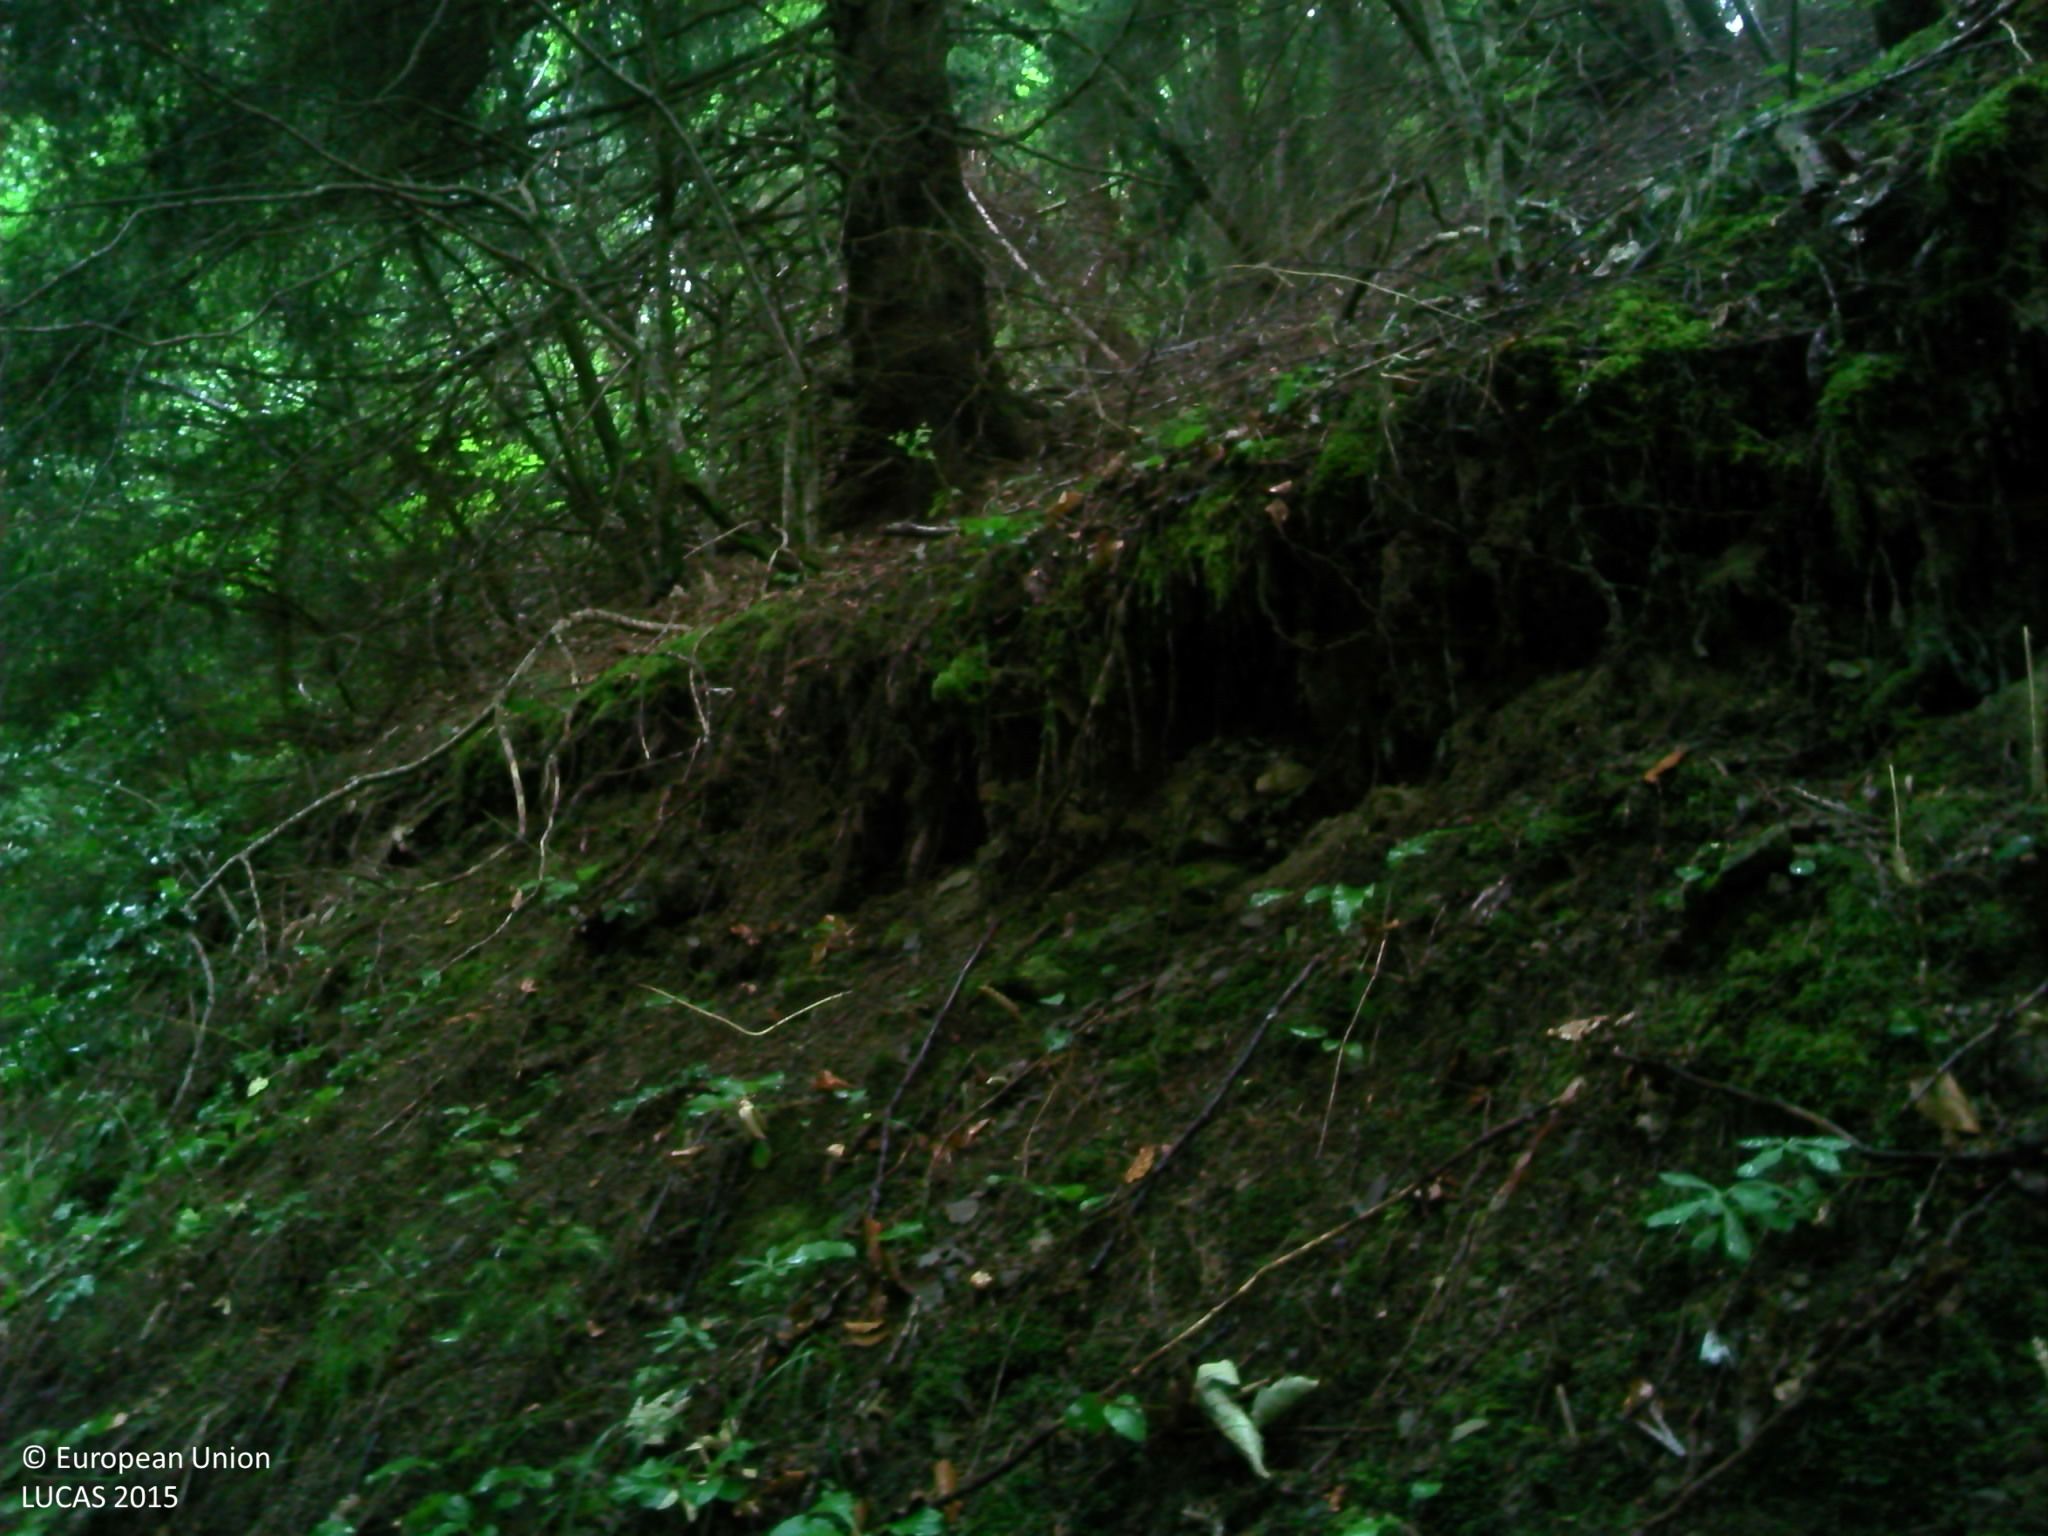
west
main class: Woodland
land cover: Spruce dominated coniferous woodland
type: alpine coniferous forest
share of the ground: > 75 %
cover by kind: coniferous forest trees 70 %, broadleaved forest trees 15 %, herbaceous plants 10 %, lichens and mosses 5 %
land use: Forestry
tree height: > 5 m
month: July
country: FR
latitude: 45.9420
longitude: 6.2245
